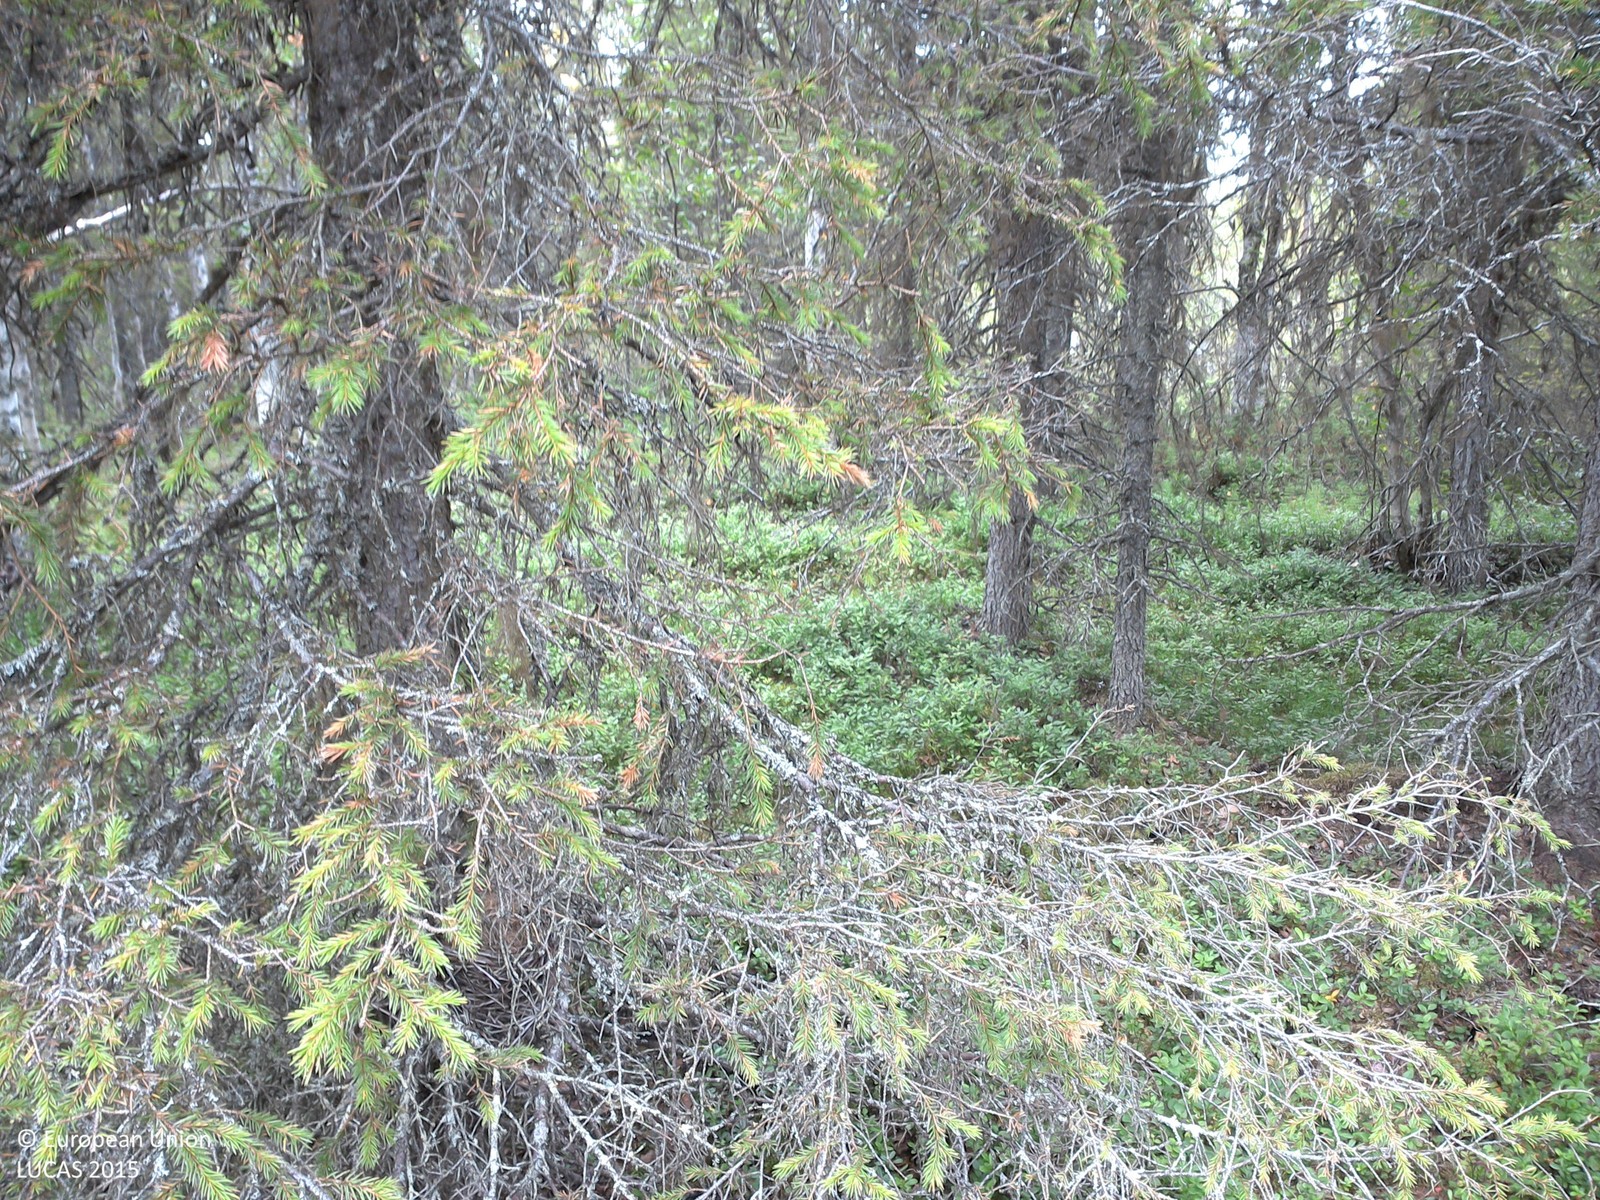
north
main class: Woodland
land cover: Spruce dominated mixed woodland
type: boreal forest
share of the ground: 25 - 50 %
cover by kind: shrubs 50 %, coniferous forest trees 25 %, lichens and mosses 15 %, broadleaved forest trees 10 %
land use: Forestry
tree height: > 5 m
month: August
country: SE
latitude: 67.2824
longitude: 21.9524
